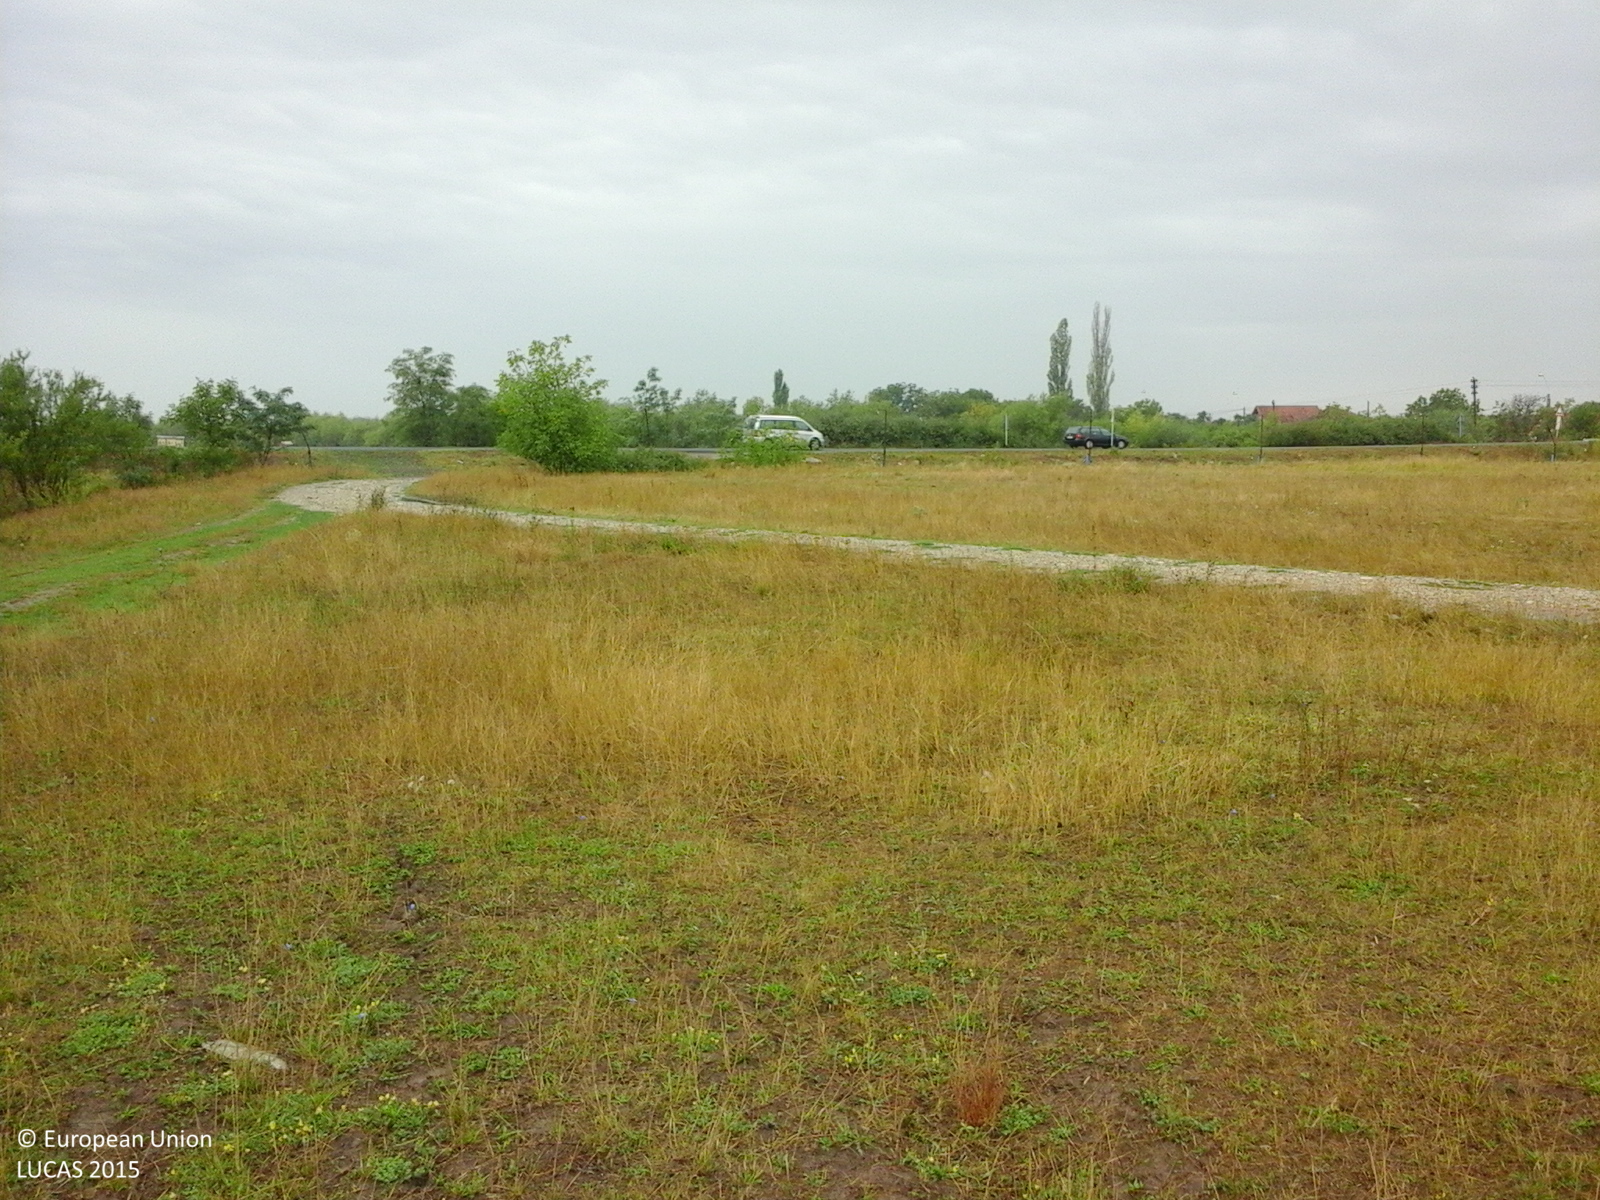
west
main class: Grassland
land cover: Grassland without tree/shrub cover
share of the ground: > 75 %
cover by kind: herbaceous plants 100 %
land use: Agriculture (excluding fallow land and kitchen gardens)
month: August
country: RO
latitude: 45.4256
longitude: 21.4444
